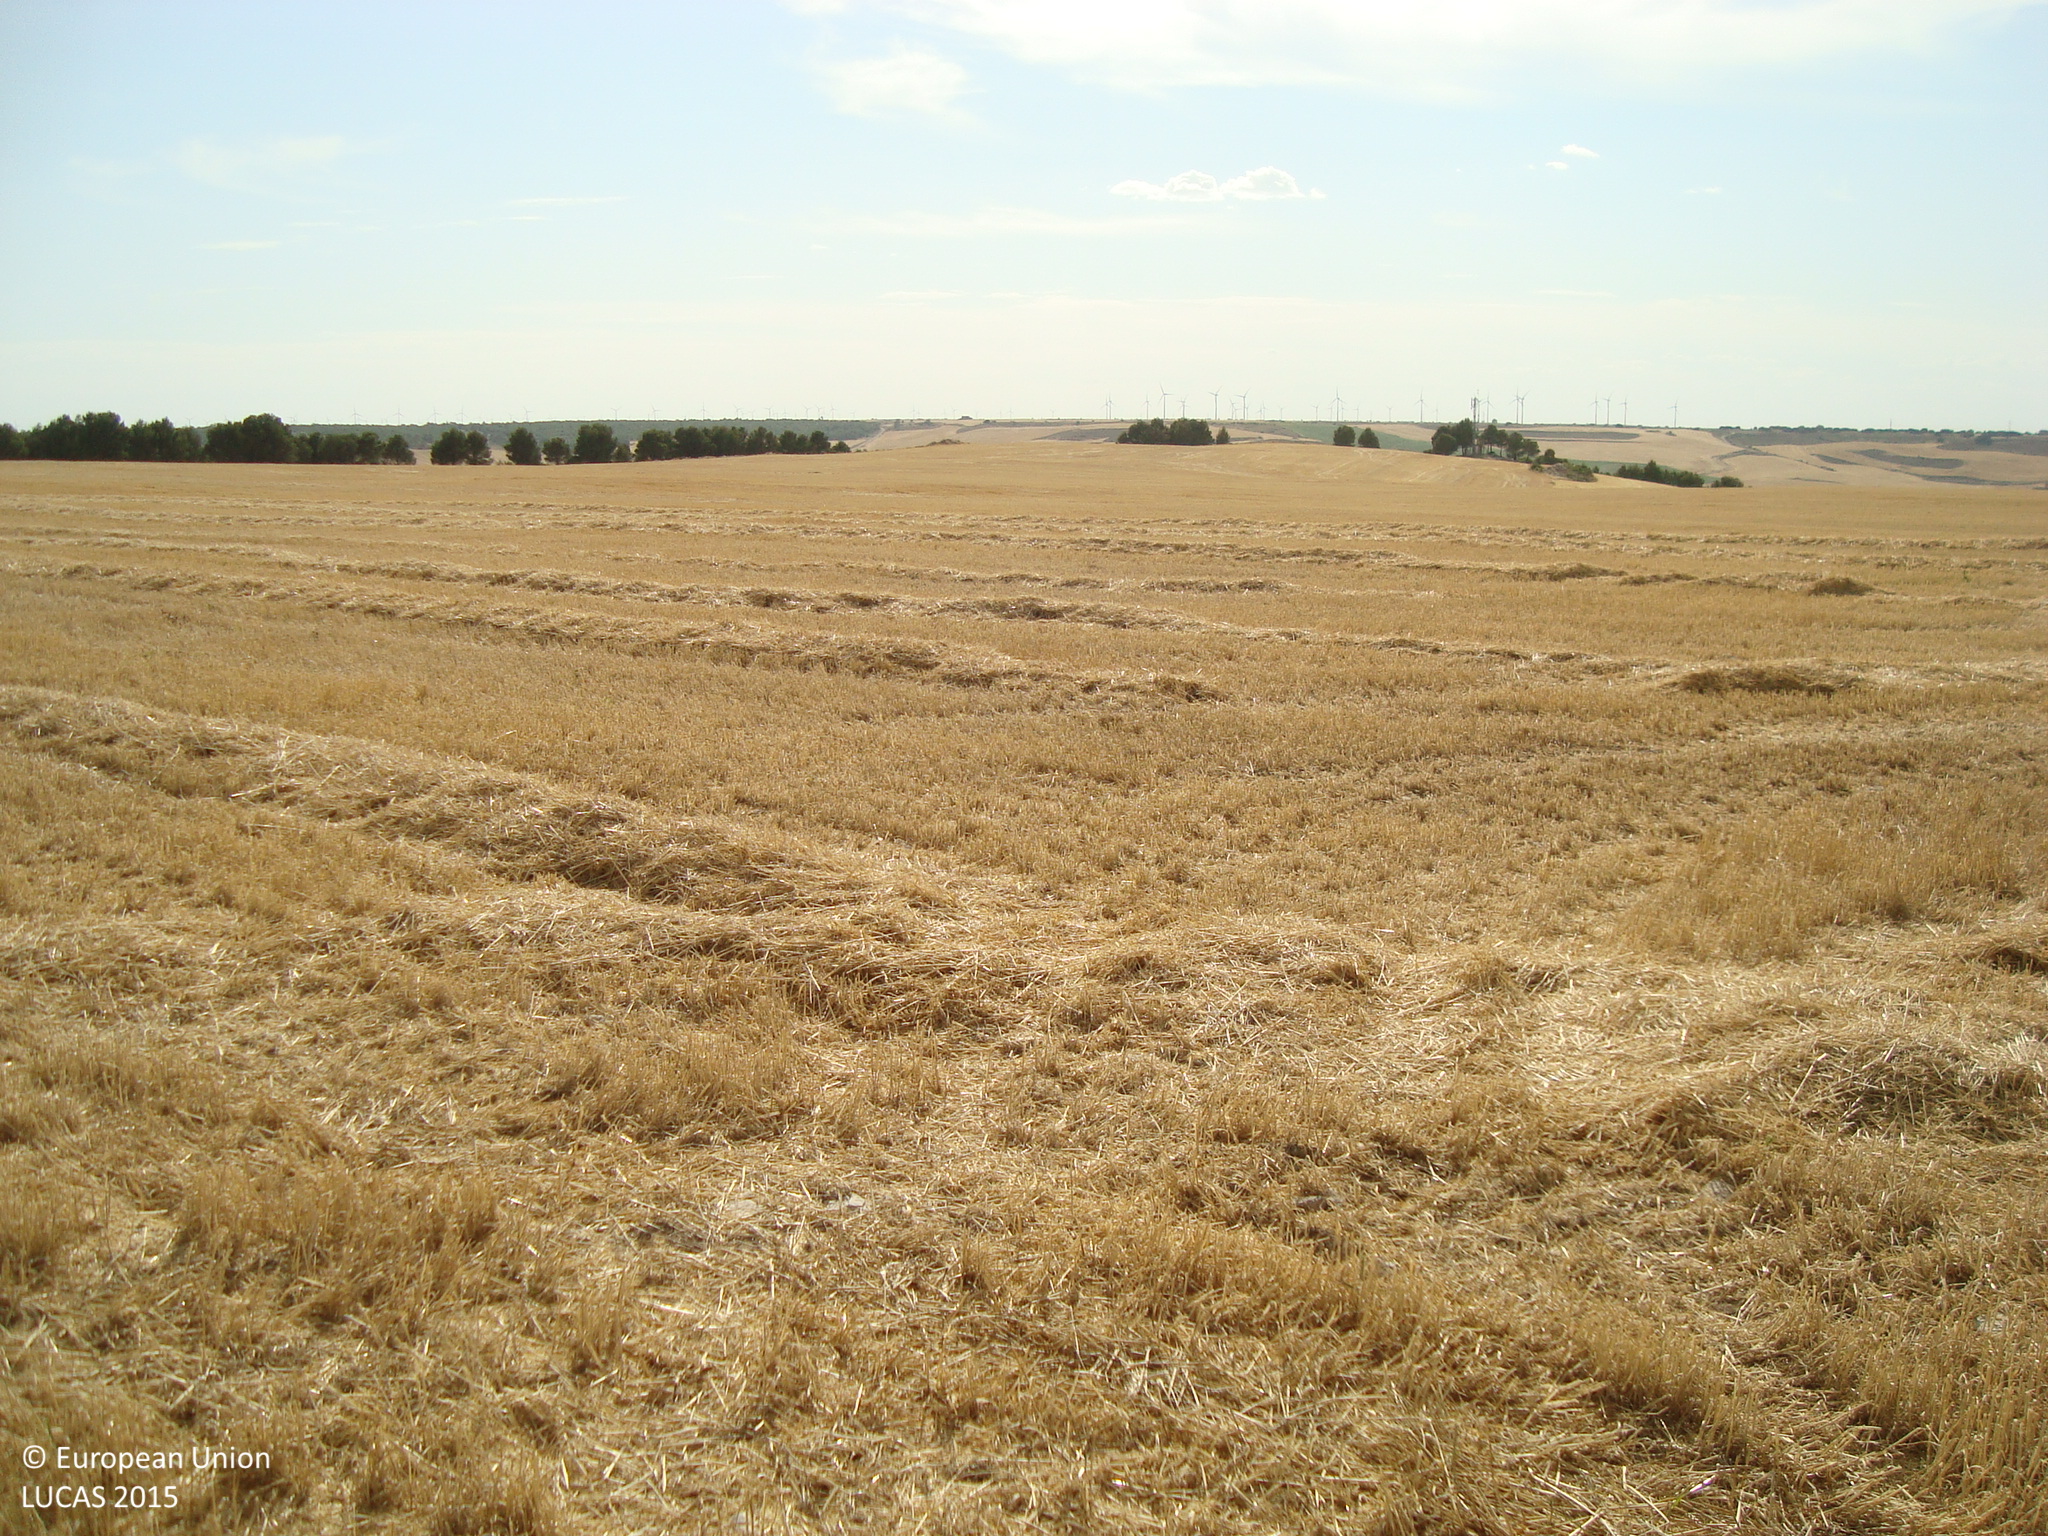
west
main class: Cropland
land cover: Common wheat
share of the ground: > 75 %
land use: Agriculture (excluding fallow land and kitchen gardens)
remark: Harvested field
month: July
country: ES
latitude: 42.0268
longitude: -4.1099
